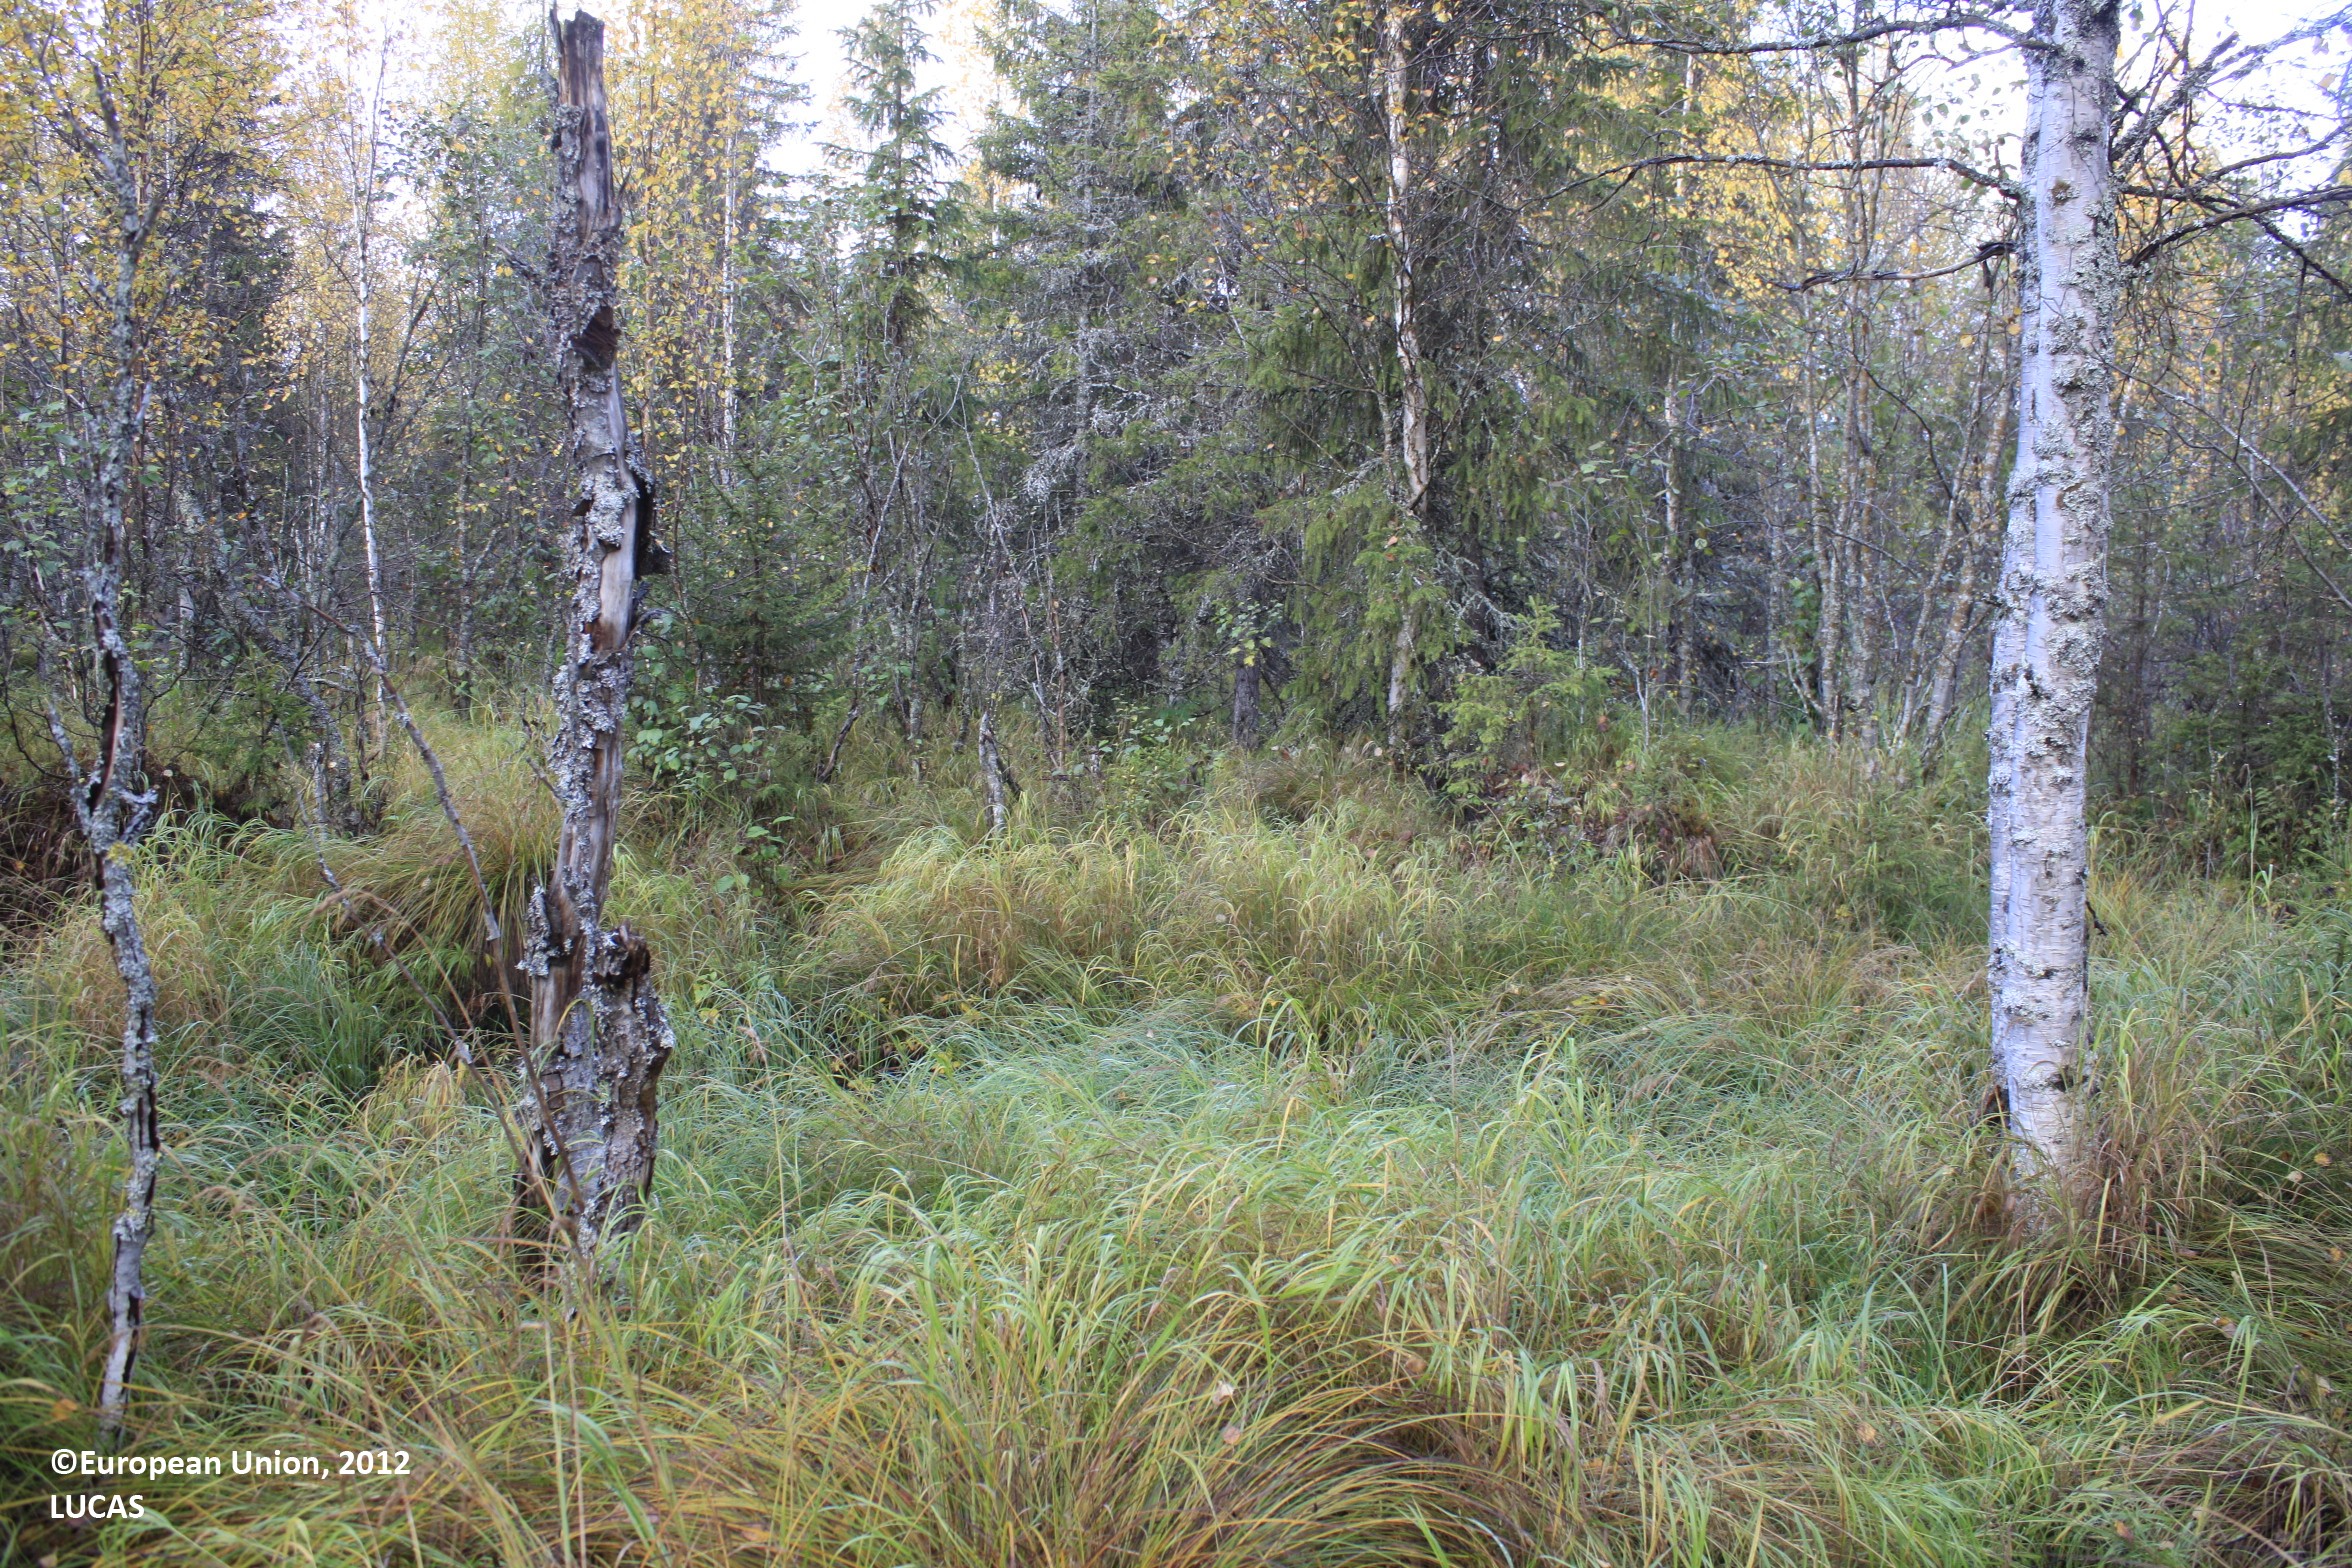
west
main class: Woodland
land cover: Spruce dominated mixed woodland
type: mire and swamp forests
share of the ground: 25 - 50 %
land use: Semi-natural and natural areas not in use
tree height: > 5 m
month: September
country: FI
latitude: 65.5929
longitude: 27.3215
